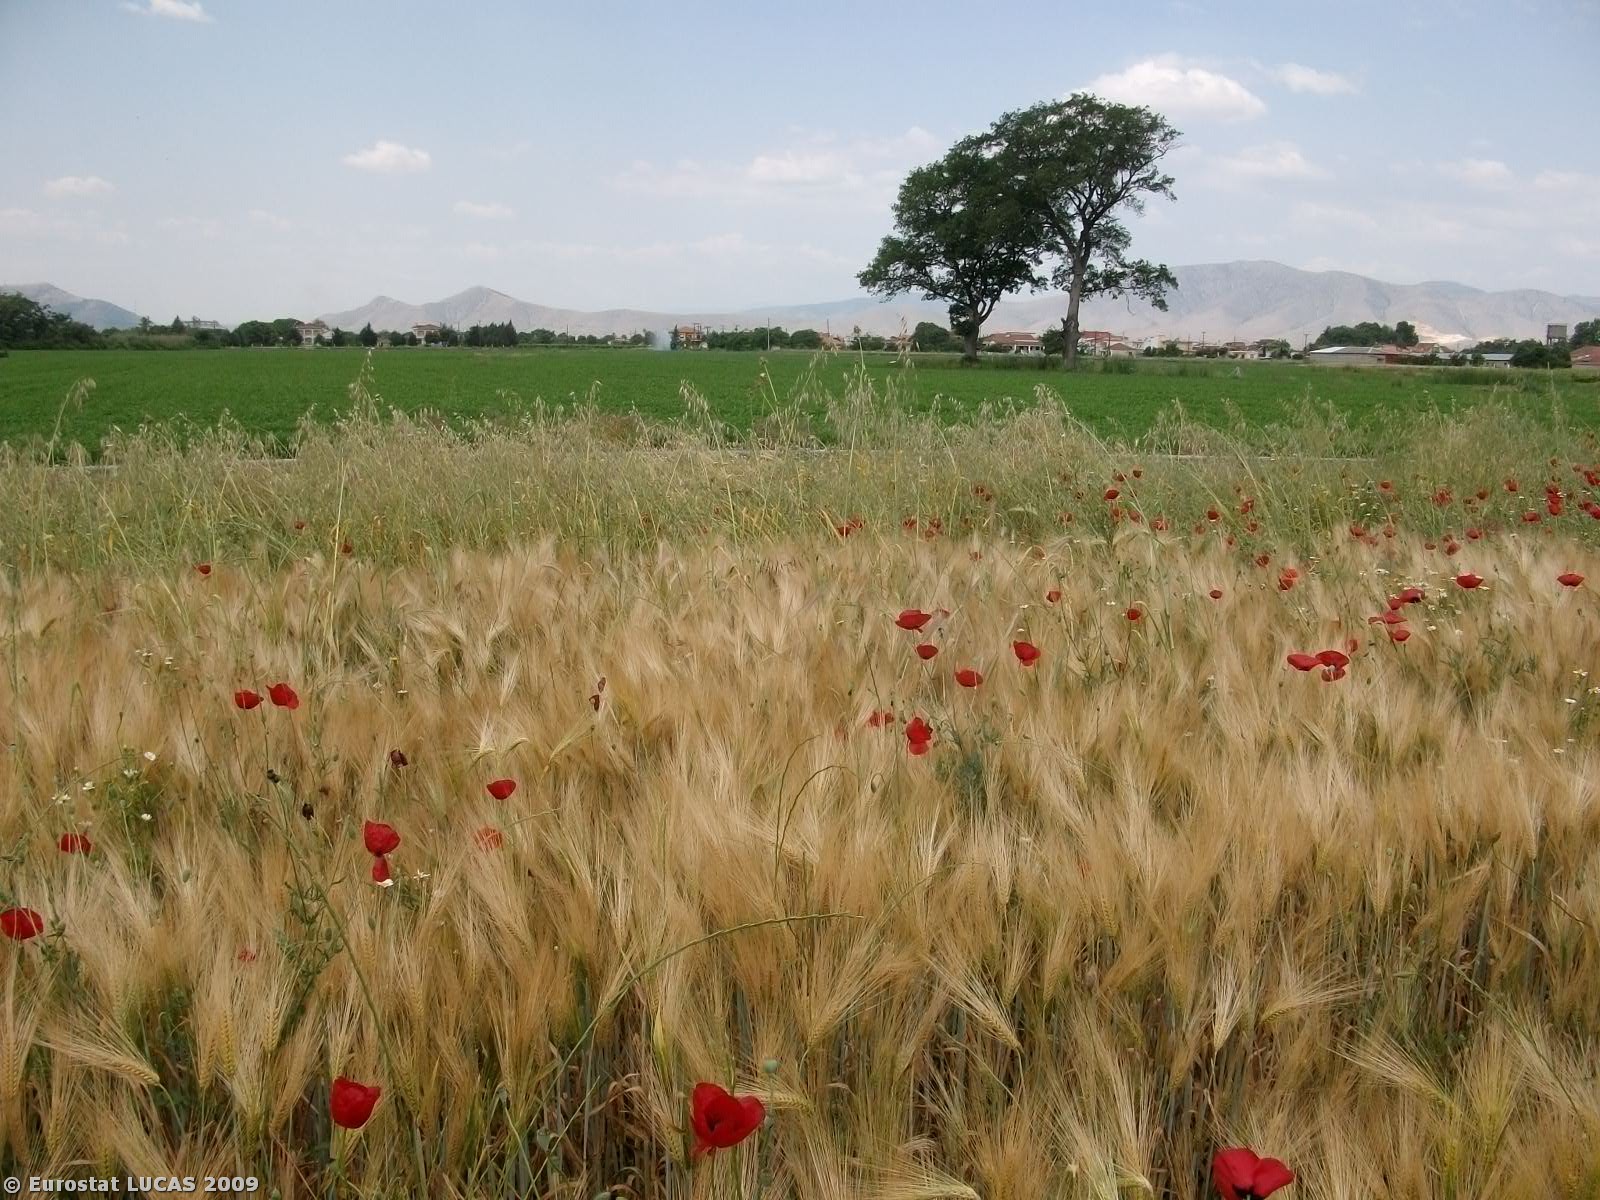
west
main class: Cropland
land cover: Durum wheat
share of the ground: > 75 %
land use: Agriculture (excluding fallow land and kitchen gardens)
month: May
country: GR
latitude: 39.7371
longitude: 22.3710
